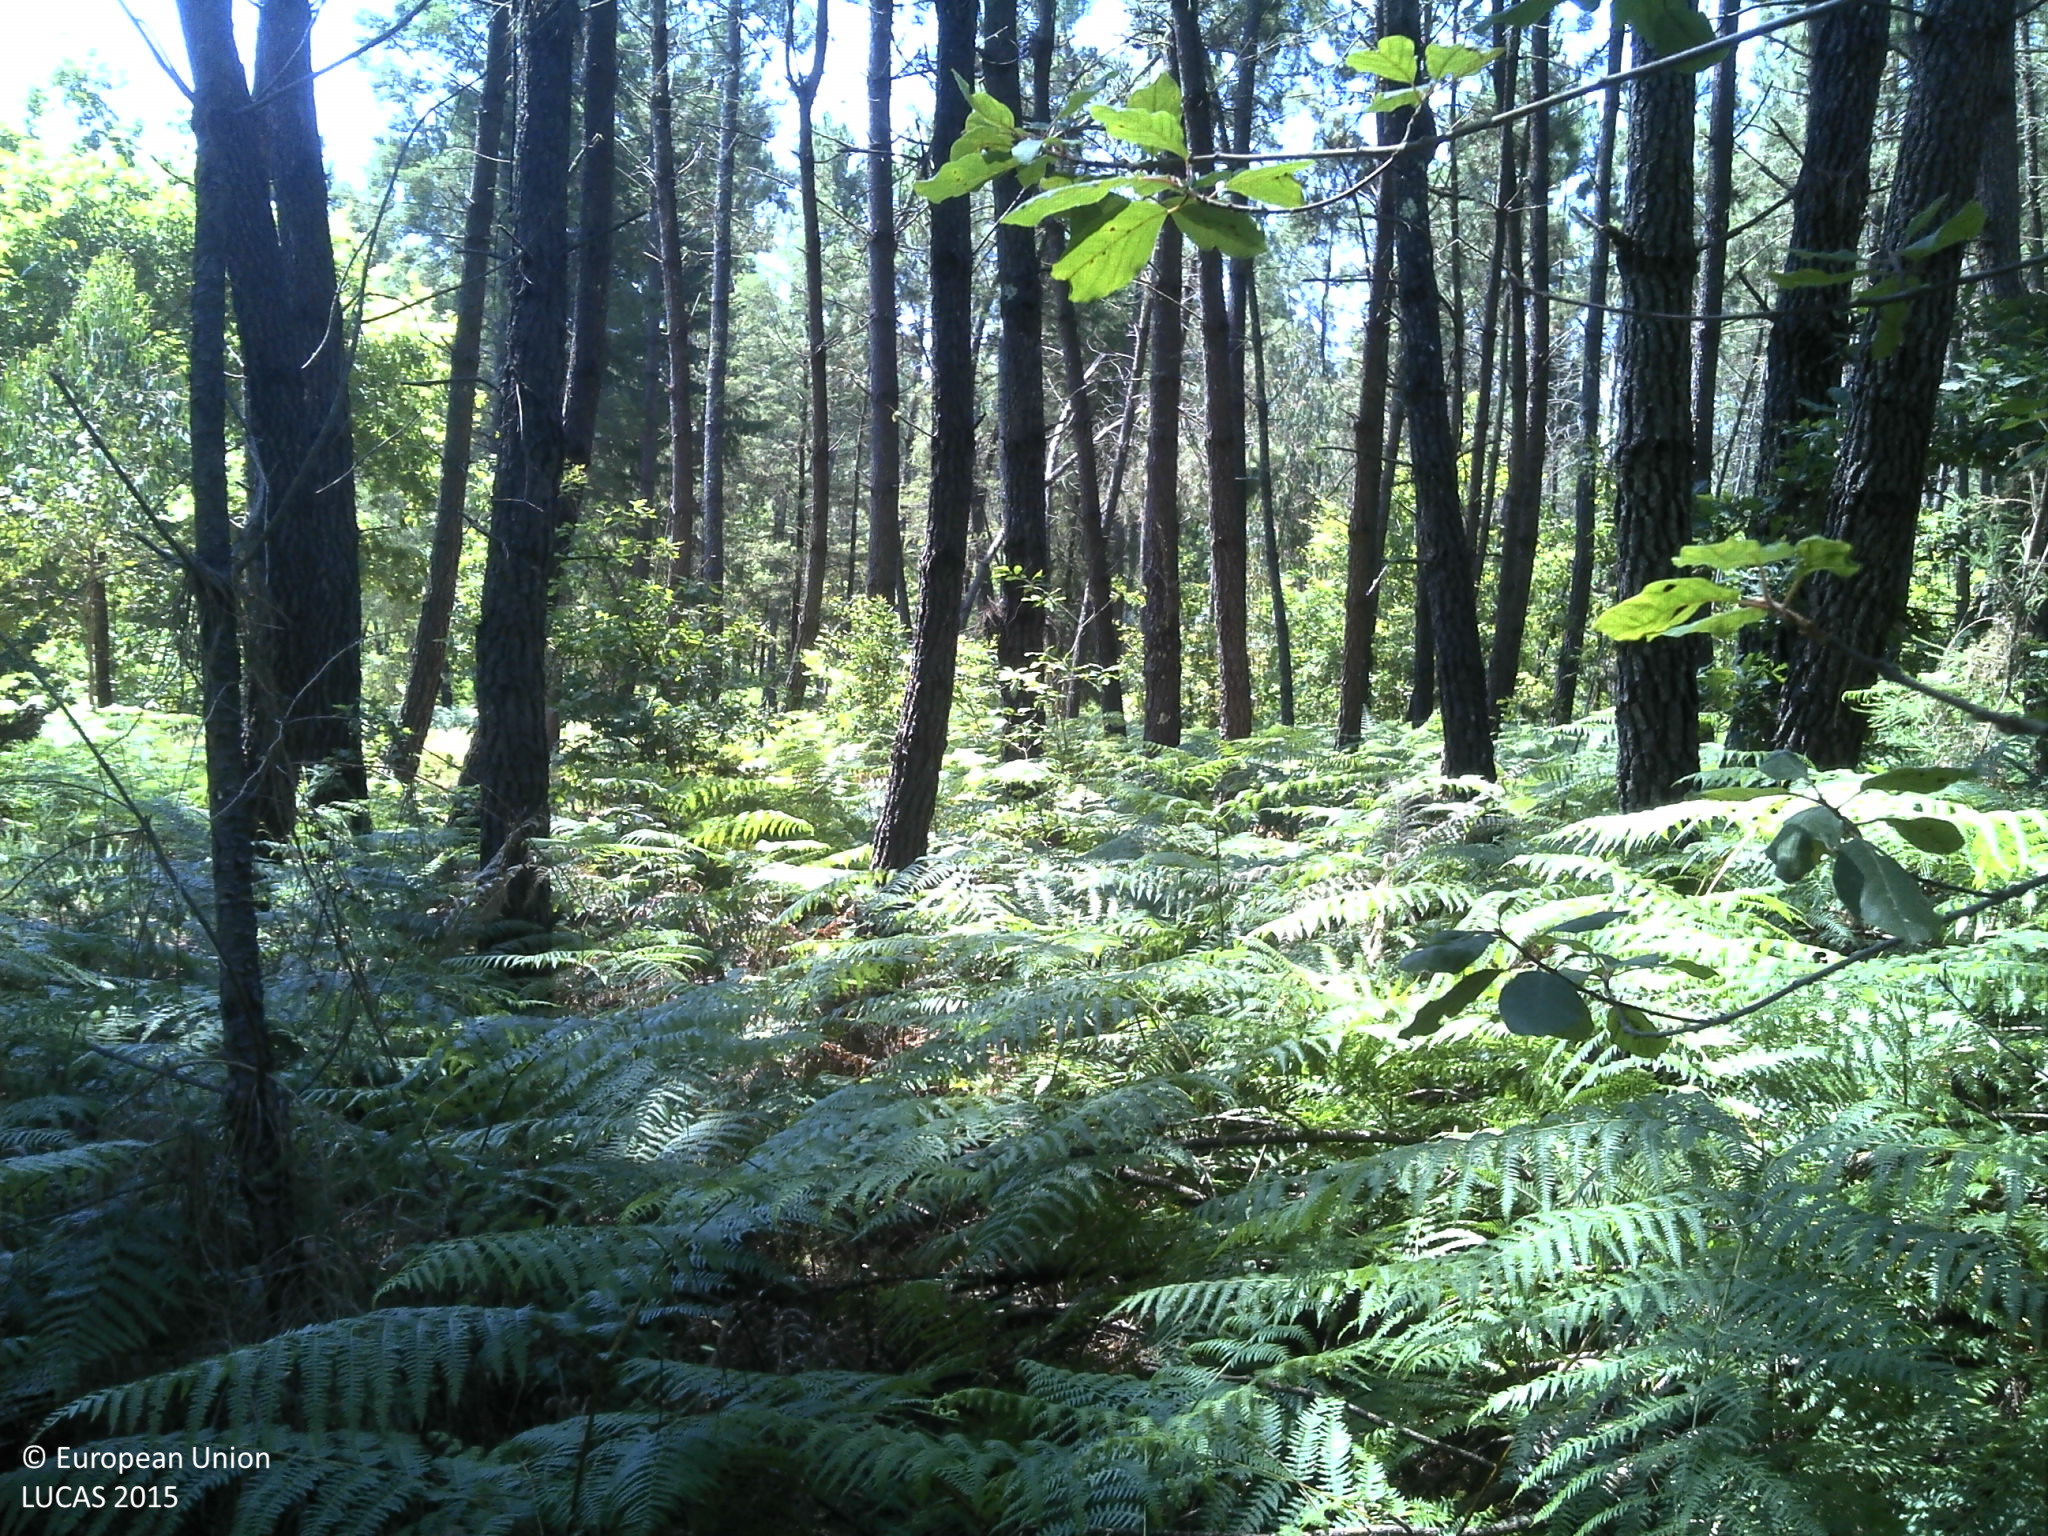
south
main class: Woodland
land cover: Pine dominated coniferous woodland
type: coniferous forest of the mediterranean region
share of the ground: 50 - 75 %
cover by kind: coniferous forest trees 60 %, shrubs 25 %, unconsolidated bare surface 10 %, herbaceous plants 5 %
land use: Forestry
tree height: > 5 m
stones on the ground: < 10 %
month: June
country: PT
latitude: 40.5606
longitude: -8.0183
